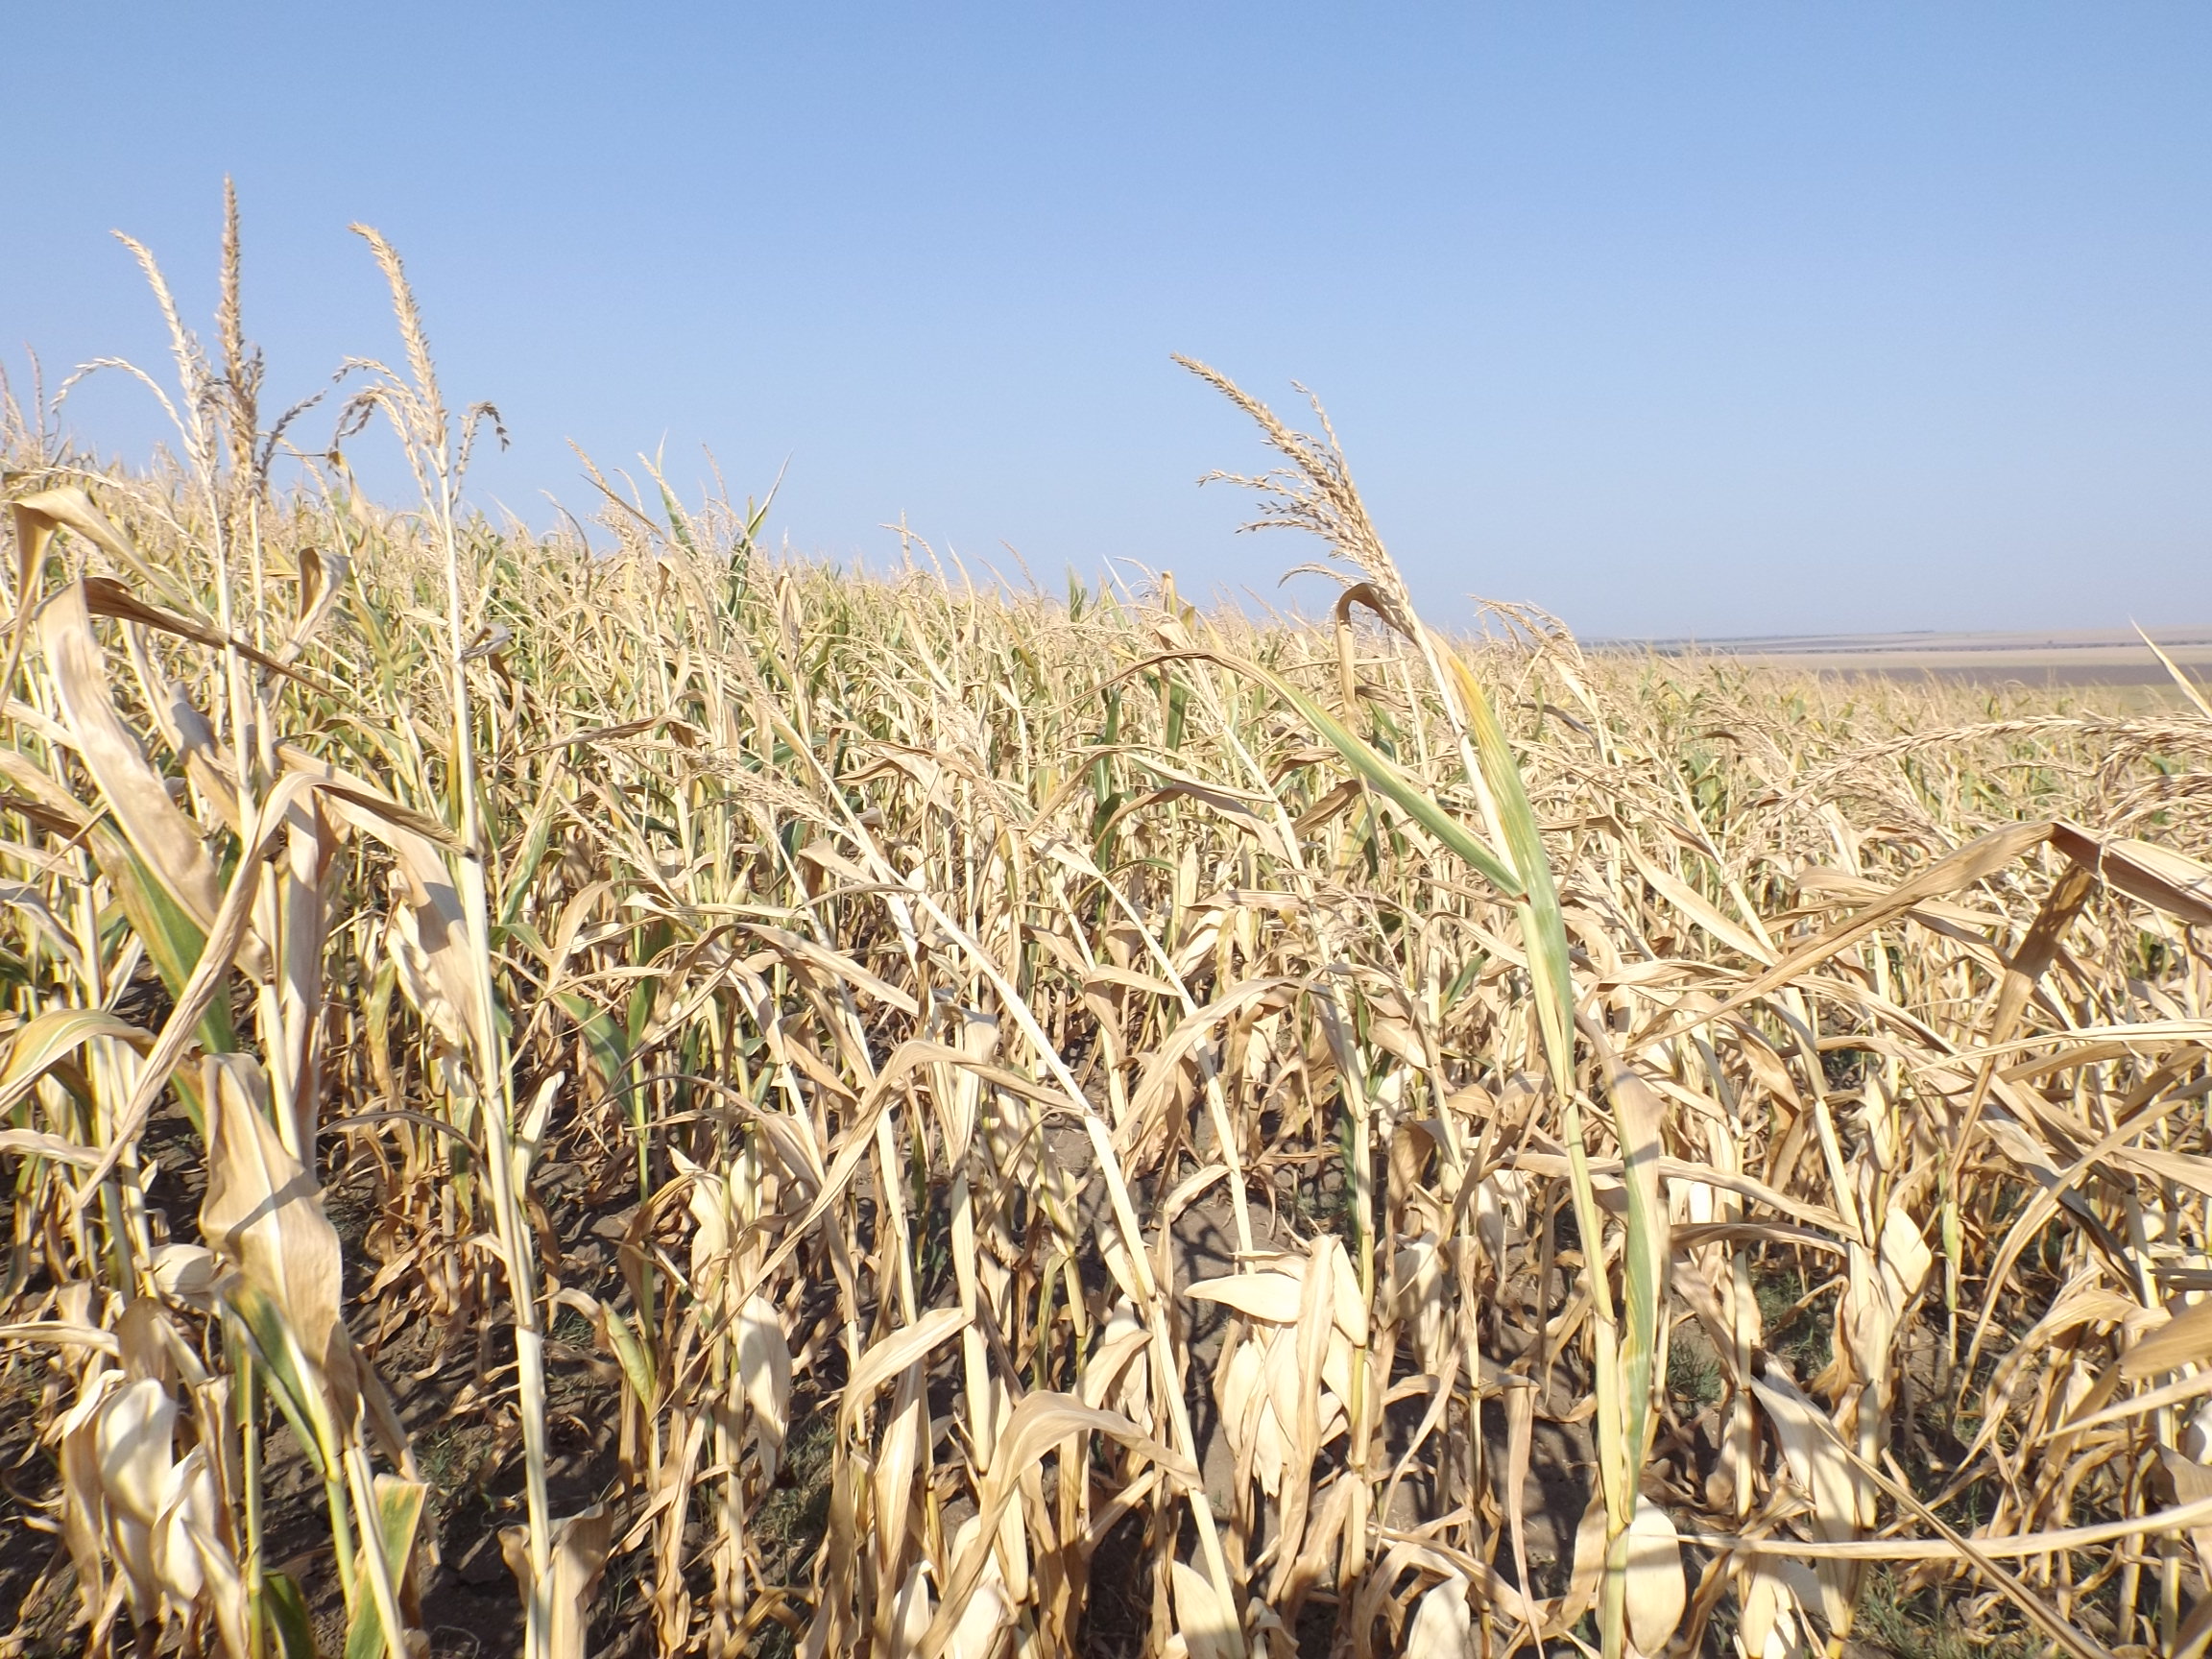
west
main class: Cropland
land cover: Maize
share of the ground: > 75 %
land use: Agriculture (excluding fallow land and kitchen gardens)
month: August
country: BG
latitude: 43.4672
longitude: 27.5483
